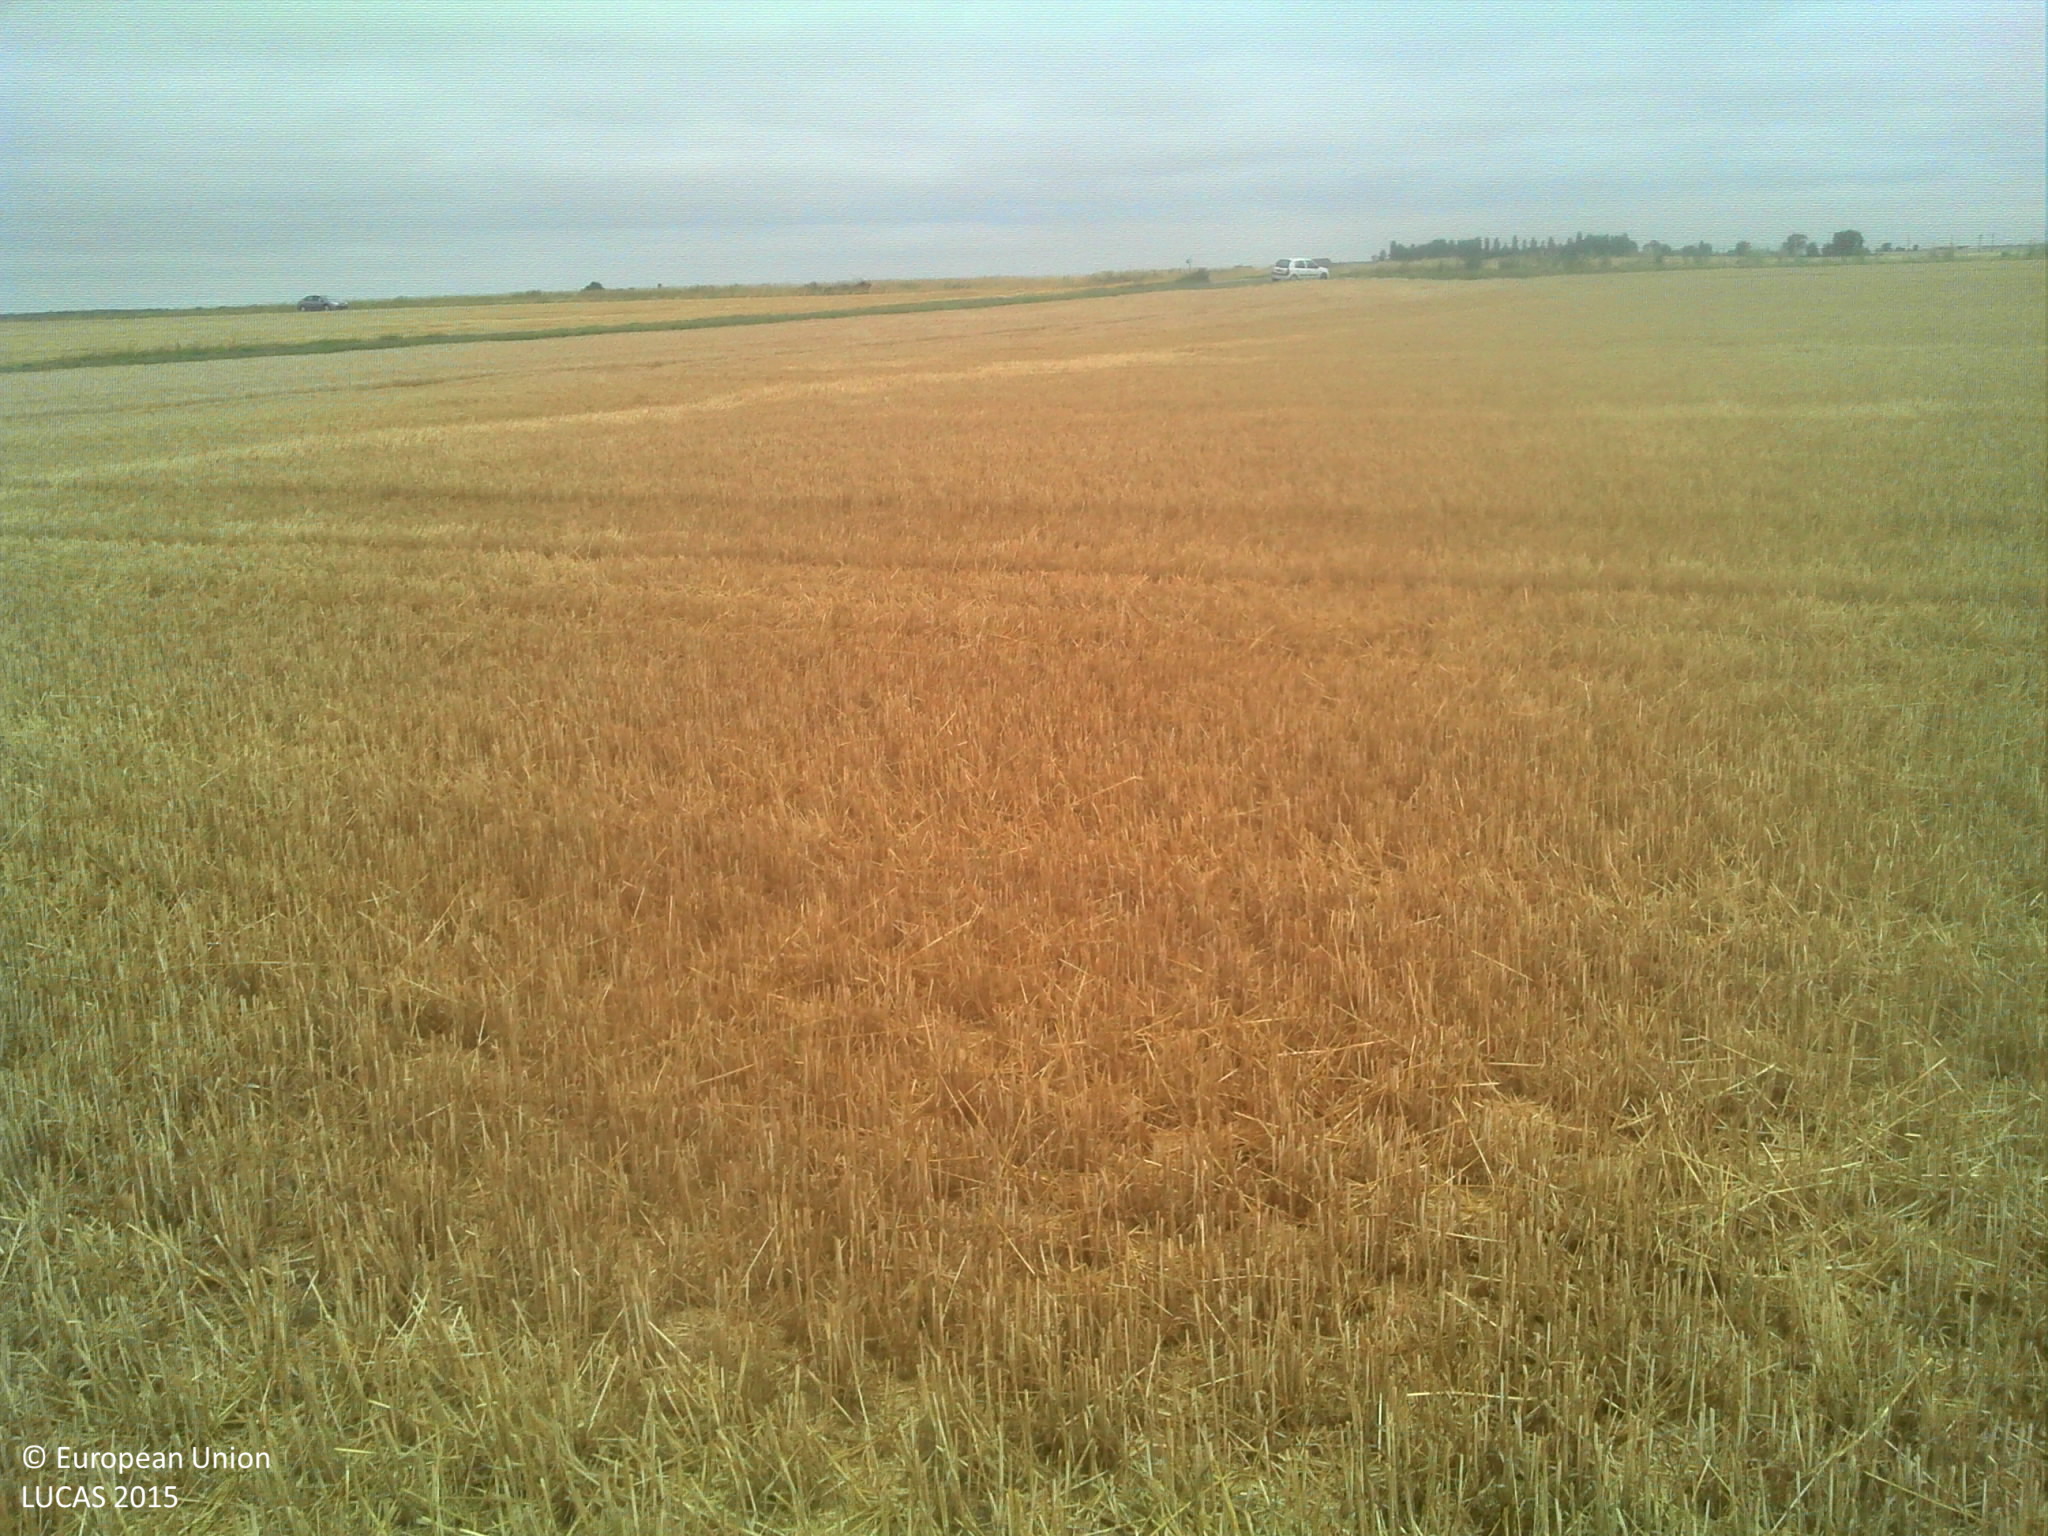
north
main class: Cropland
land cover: Durum wheat
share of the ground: > 75 %
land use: Agriculture (excluding fallow land and kitchen gardens)
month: July
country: FR
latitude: 47.7881
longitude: 1.2941
